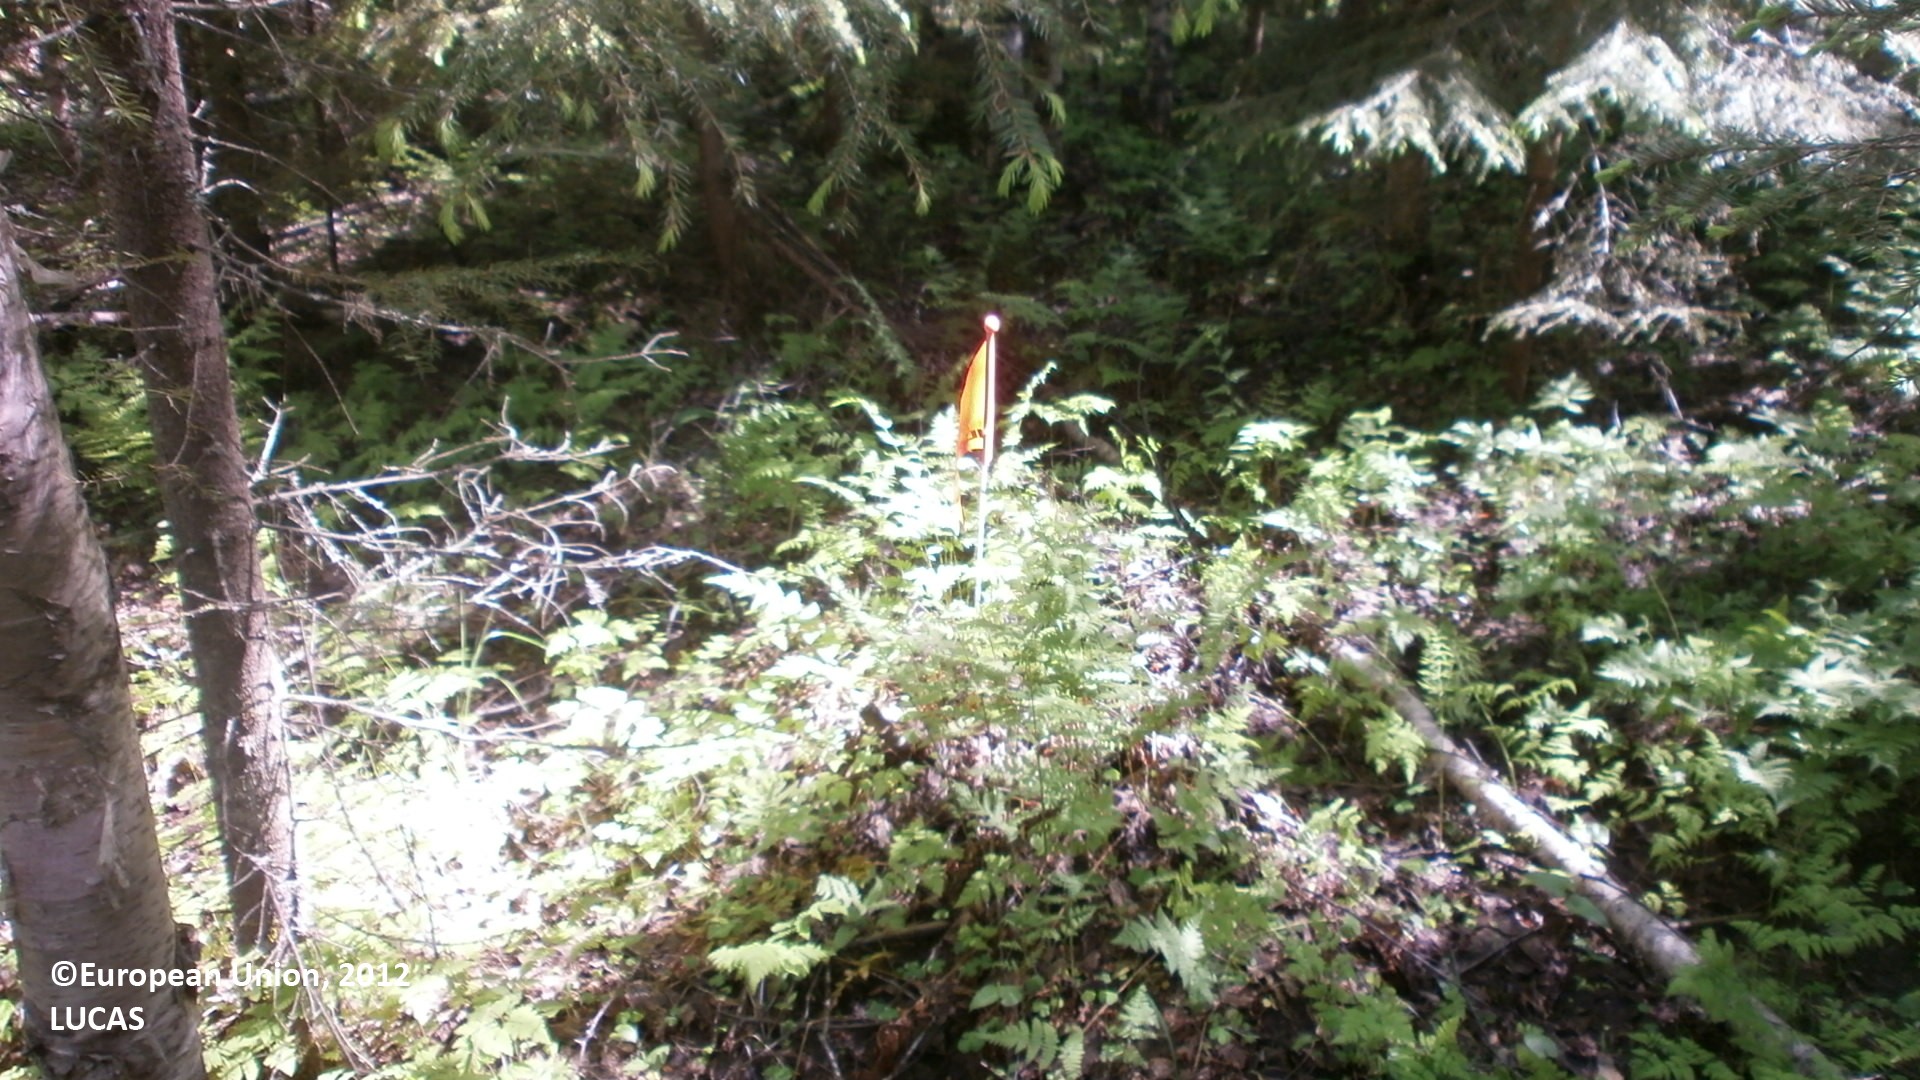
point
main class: Woodland
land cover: Spruce dominated mixed woodland
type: hemiboreal forest and nemoral coniferous forest and mixed broadleaved-coniferous forest
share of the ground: > 75 %
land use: Forestry
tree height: > 5 m
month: June
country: FI
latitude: 64.2429
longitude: 25.8378
